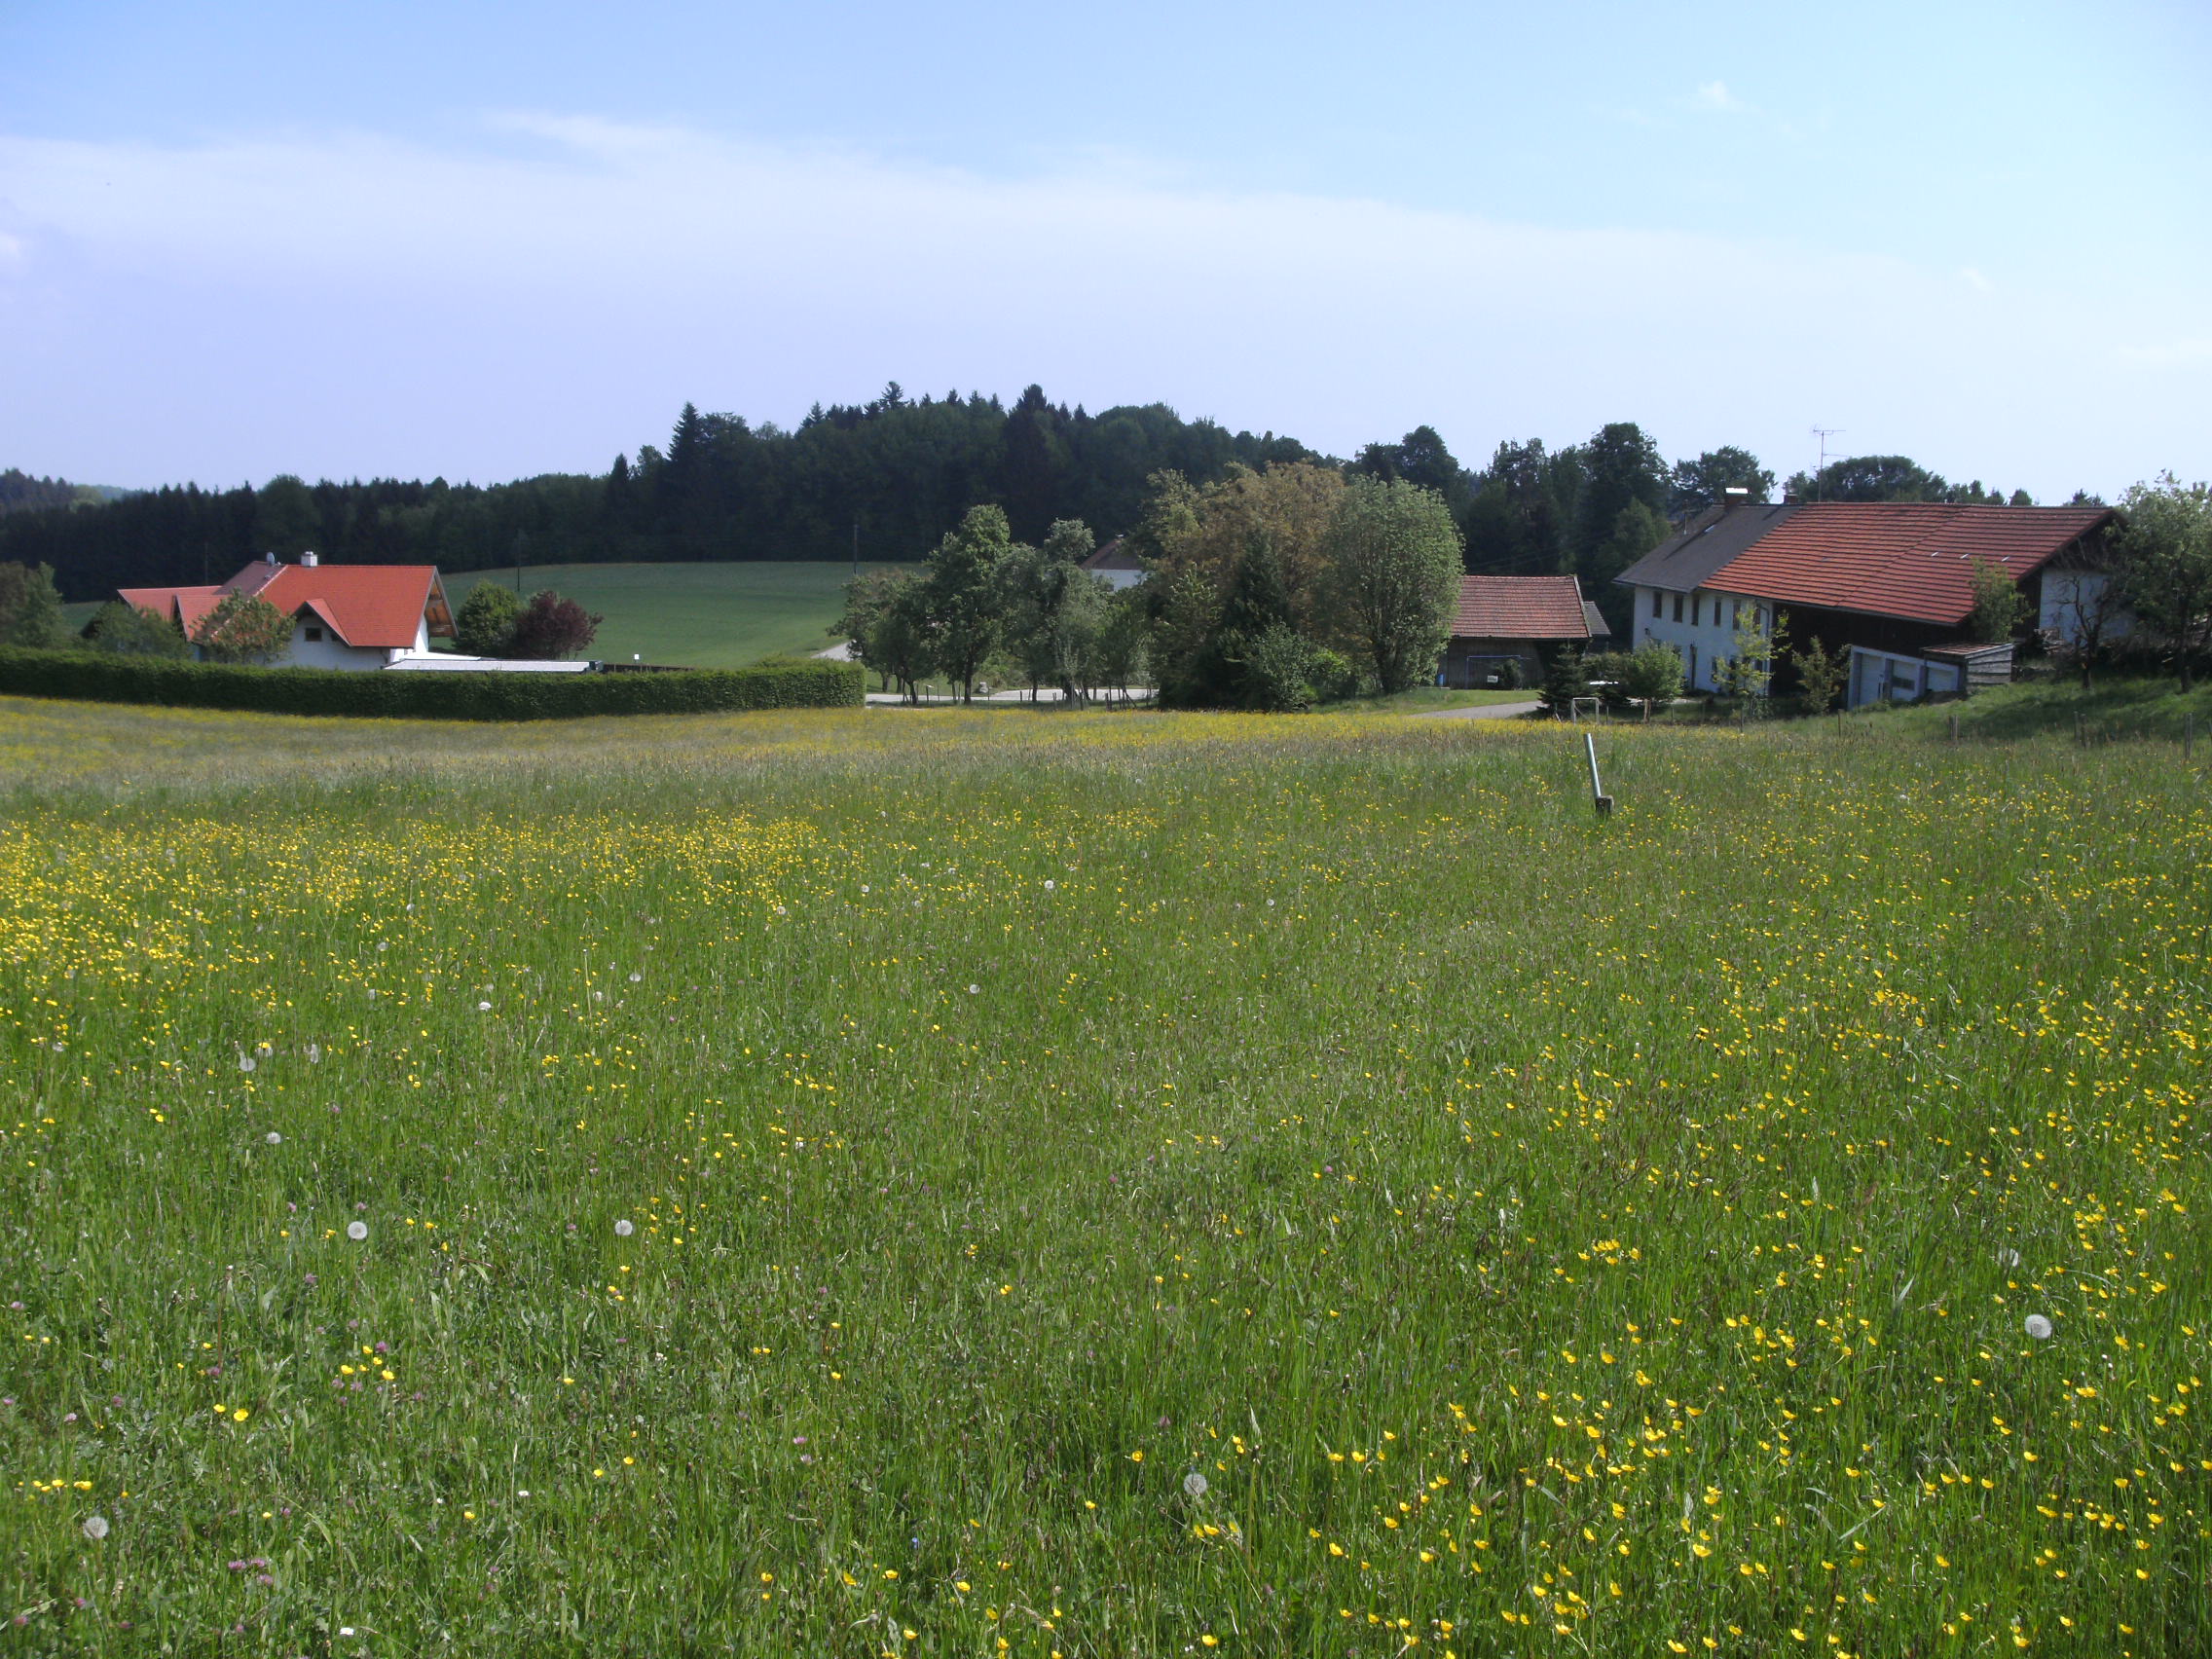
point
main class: Grassland
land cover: Grassland without tree/shrub cover
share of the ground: > 75 %
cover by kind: herbaceous plants 100 %
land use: Agriculture (excluding fallow land and kitchen gardens)
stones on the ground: < 10 %
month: May
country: AT
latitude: 48.4311
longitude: 13.7164
